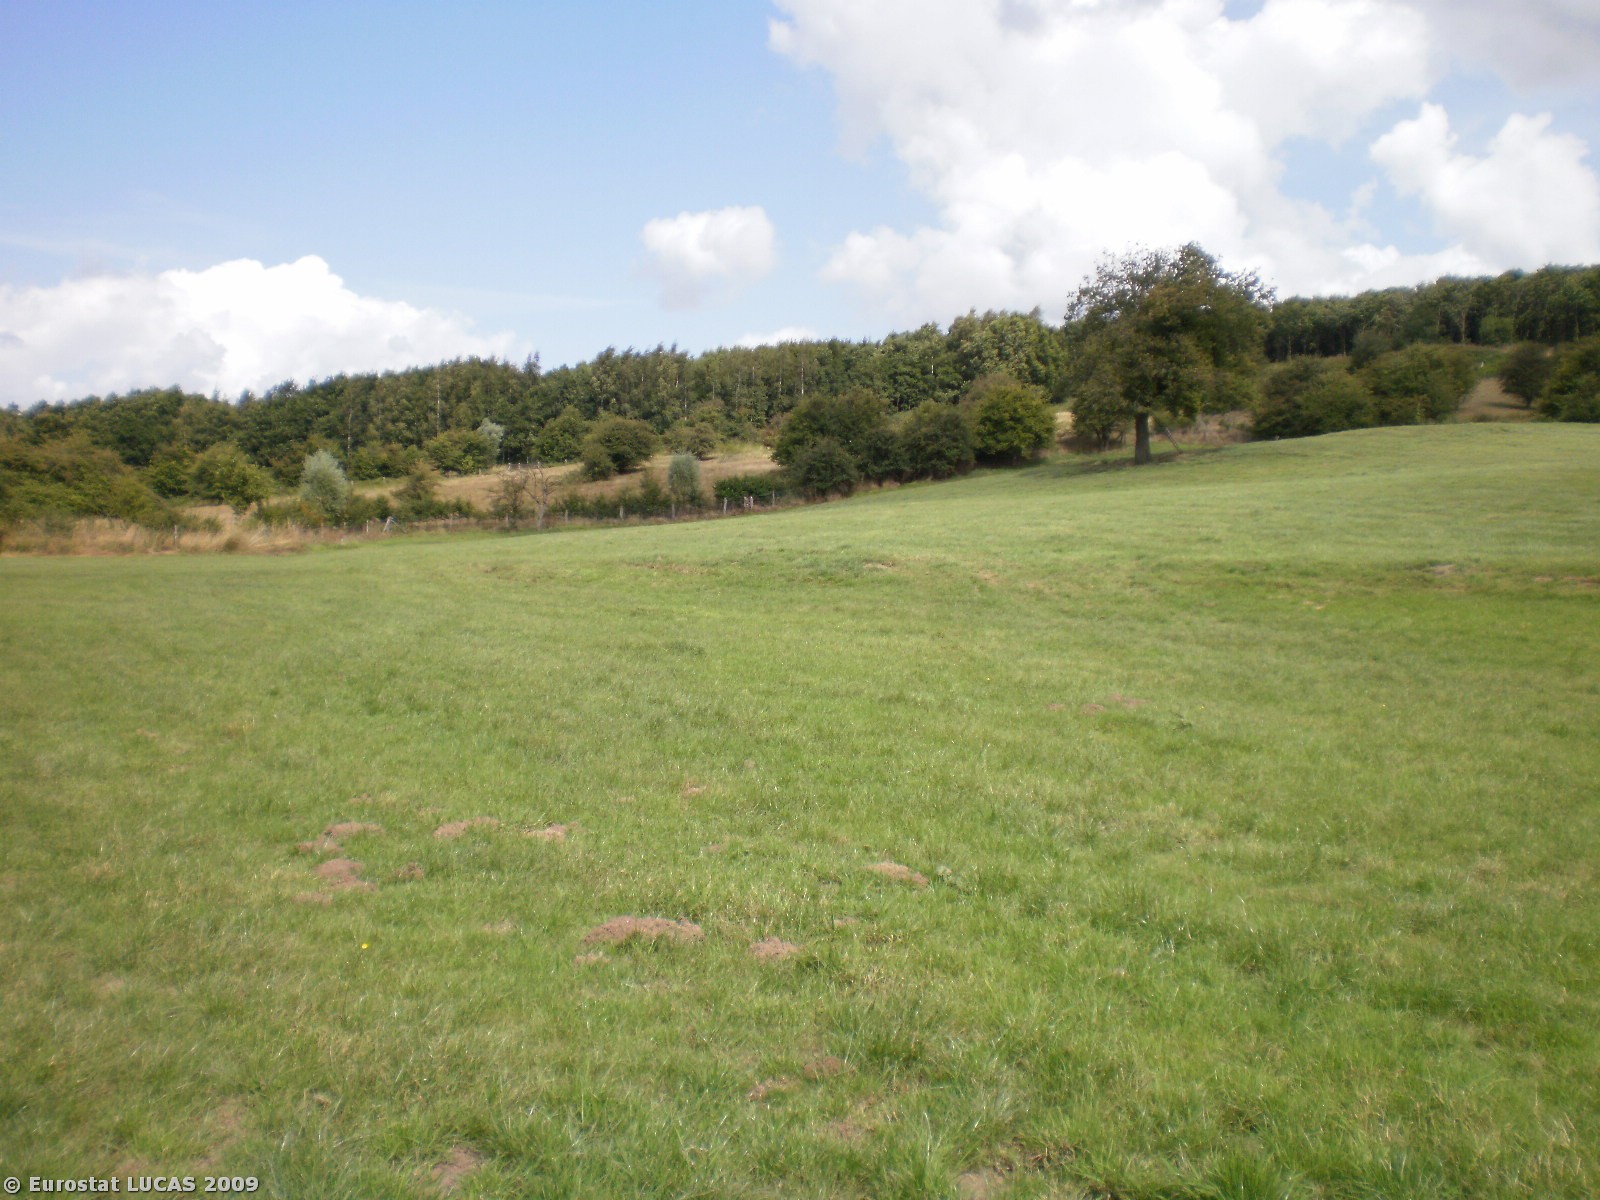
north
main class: Grassland
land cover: Grassland without tree/shrub cover
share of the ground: > 75 %
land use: Agriculture (excluding fallow land and kitchen gardens)
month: July
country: BE
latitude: 50.7671
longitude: 2.7718
